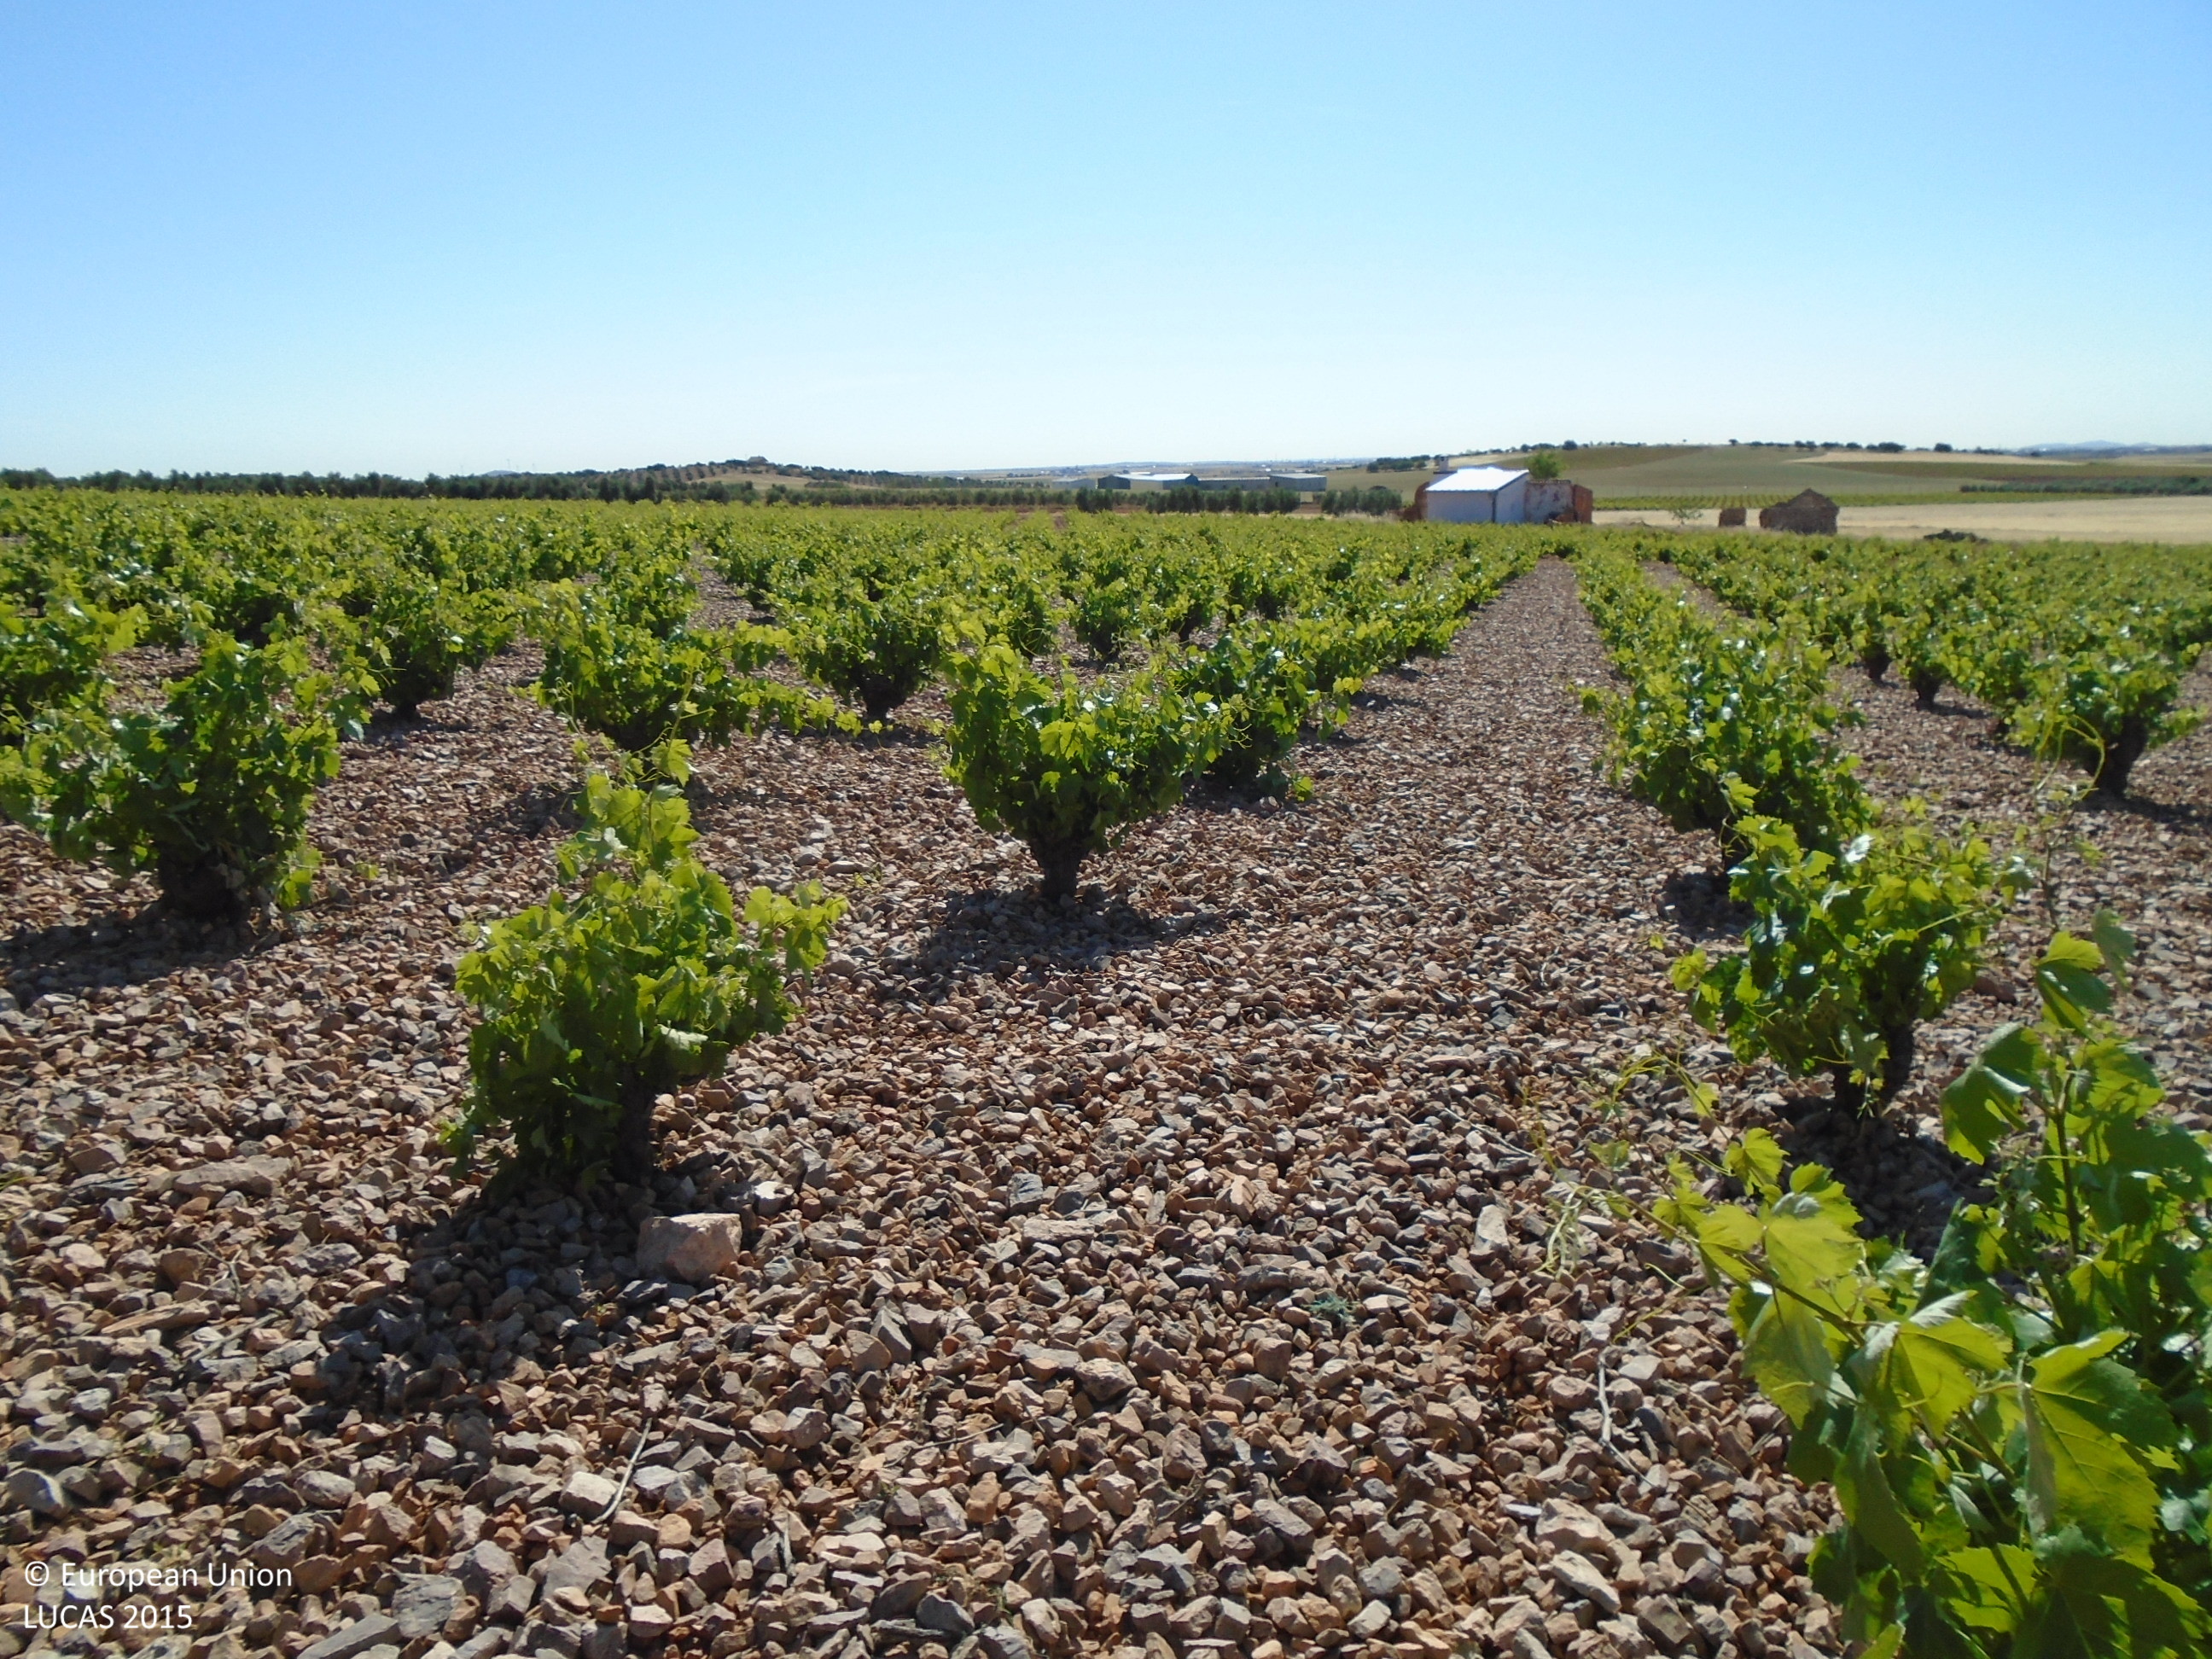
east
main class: Cropland
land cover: Vineyards
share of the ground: > 75 %
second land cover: Other bare soil
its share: > 75 %
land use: Agriculture (excluding fallow land and kitchen gardens)
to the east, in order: Vineyards; Other bare soil; Grass margins; Vineyards; Grass margins; Other bare soil; Grass margins; Tracks; Grass margins; Other bare soil
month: May
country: ES
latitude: 39.4897
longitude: -3.6632
